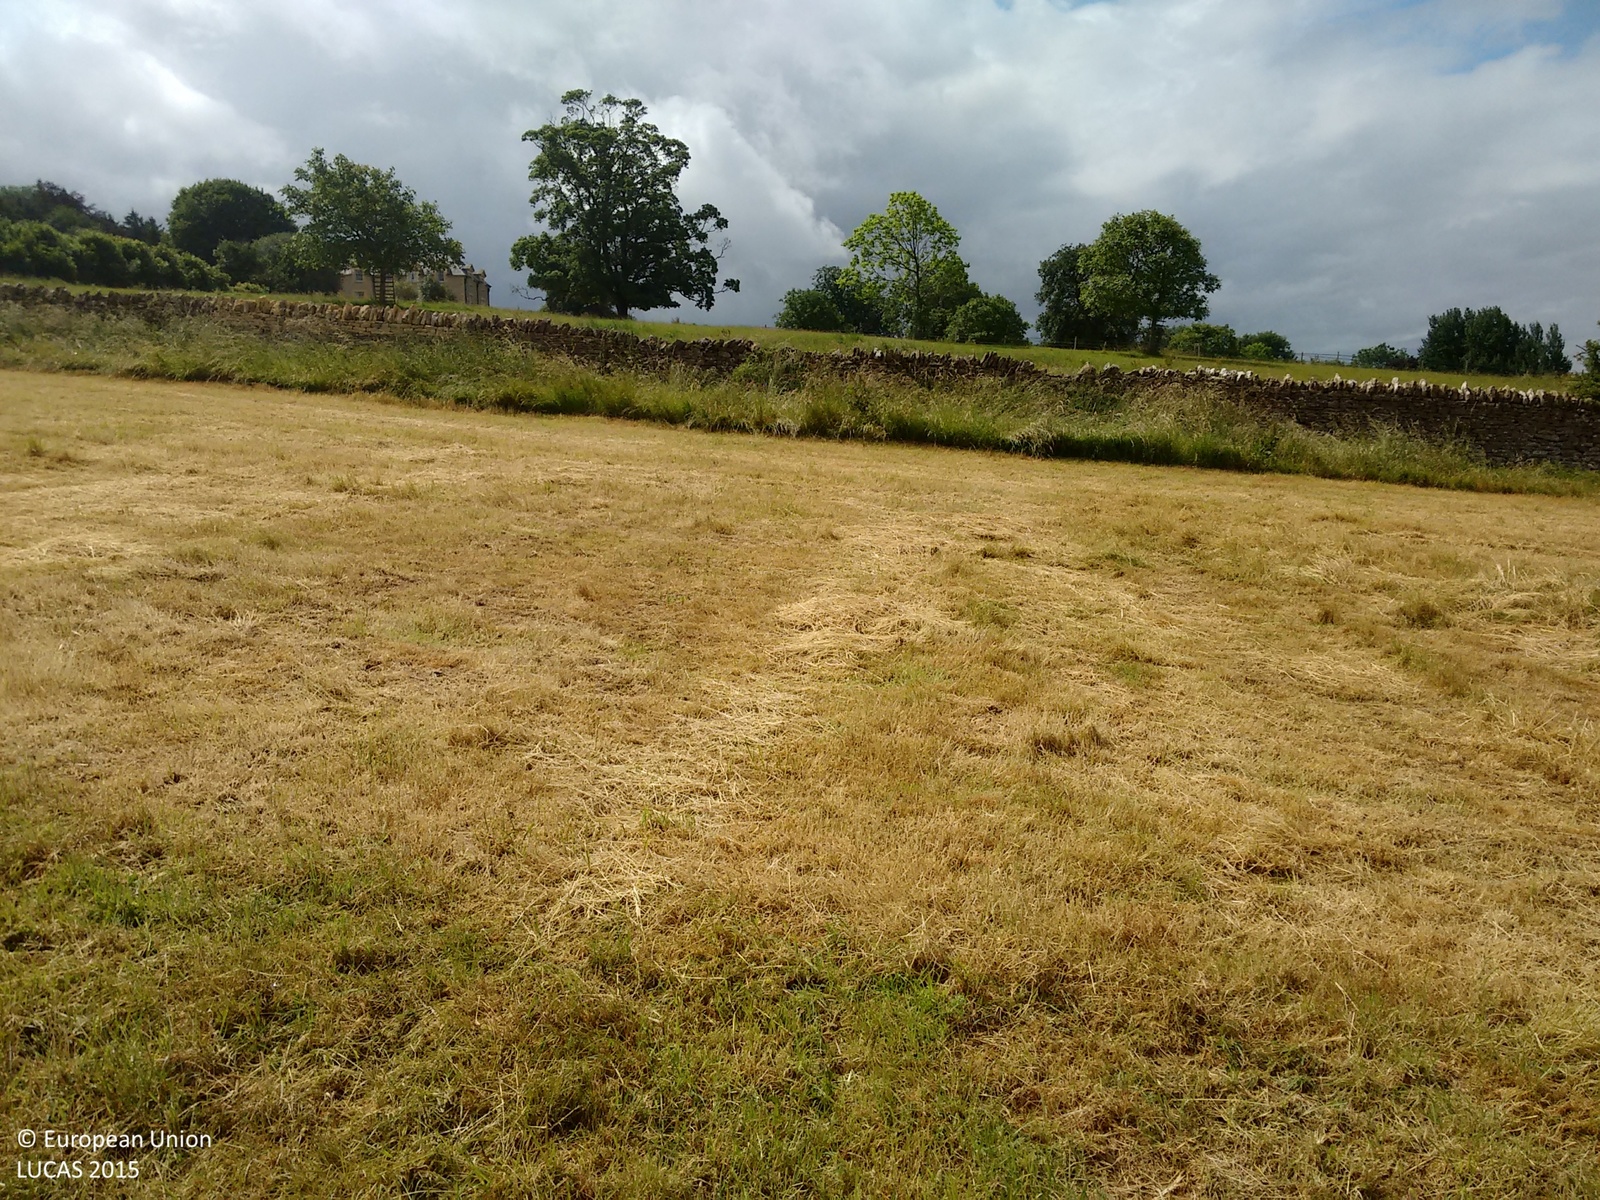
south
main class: Grassland
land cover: Grassland without tree/shrub cover
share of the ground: > 75 %
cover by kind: herbaceous plants 100 %
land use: Residential
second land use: Agriculture (excluding fallow land and kitchen gardens)
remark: Harvested field
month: July
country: GB
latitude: 51.8997
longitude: -1.5771
